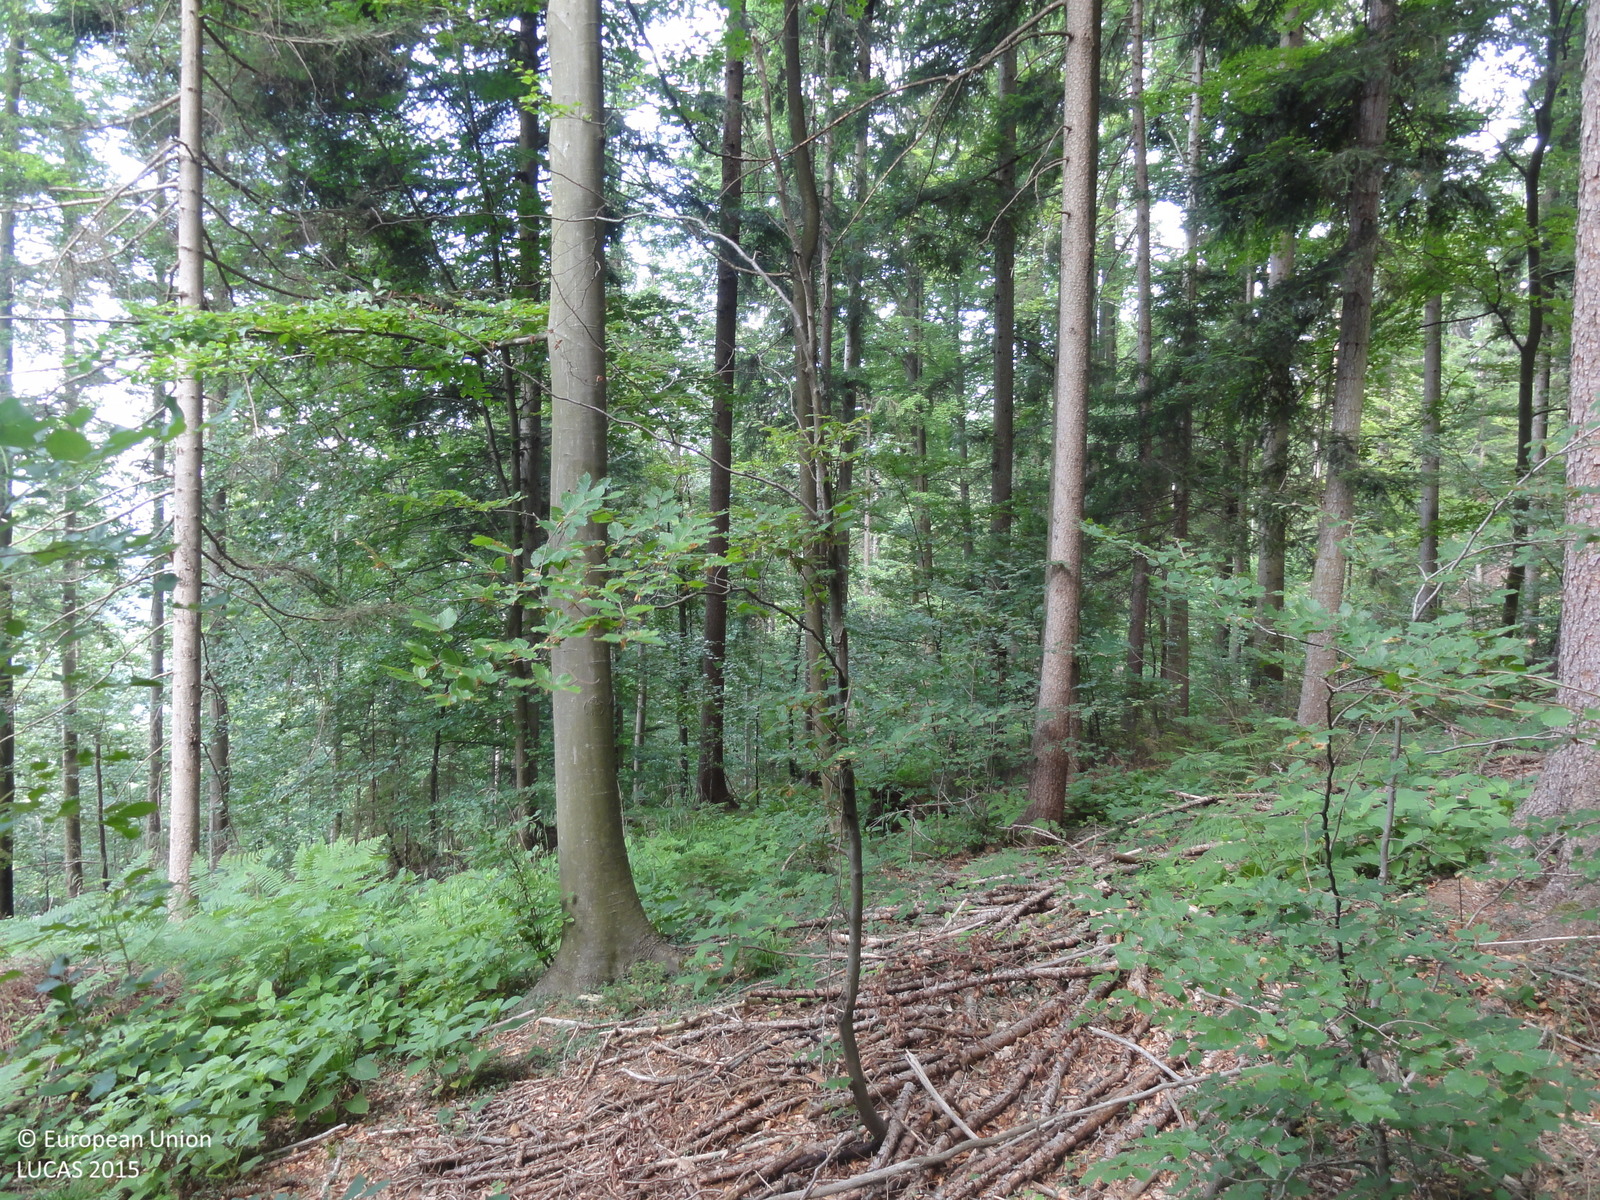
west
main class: Woodland
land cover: Spruce dominated mixed woodland
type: mountainous beech forest
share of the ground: > 75 %
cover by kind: coniferous forest trees 65 %, broadleaved forest trees 30 %, shrubs 5 %
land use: Forestry
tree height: > 5 m
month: June
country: SI
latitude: 46.3306
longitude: 14.8686
